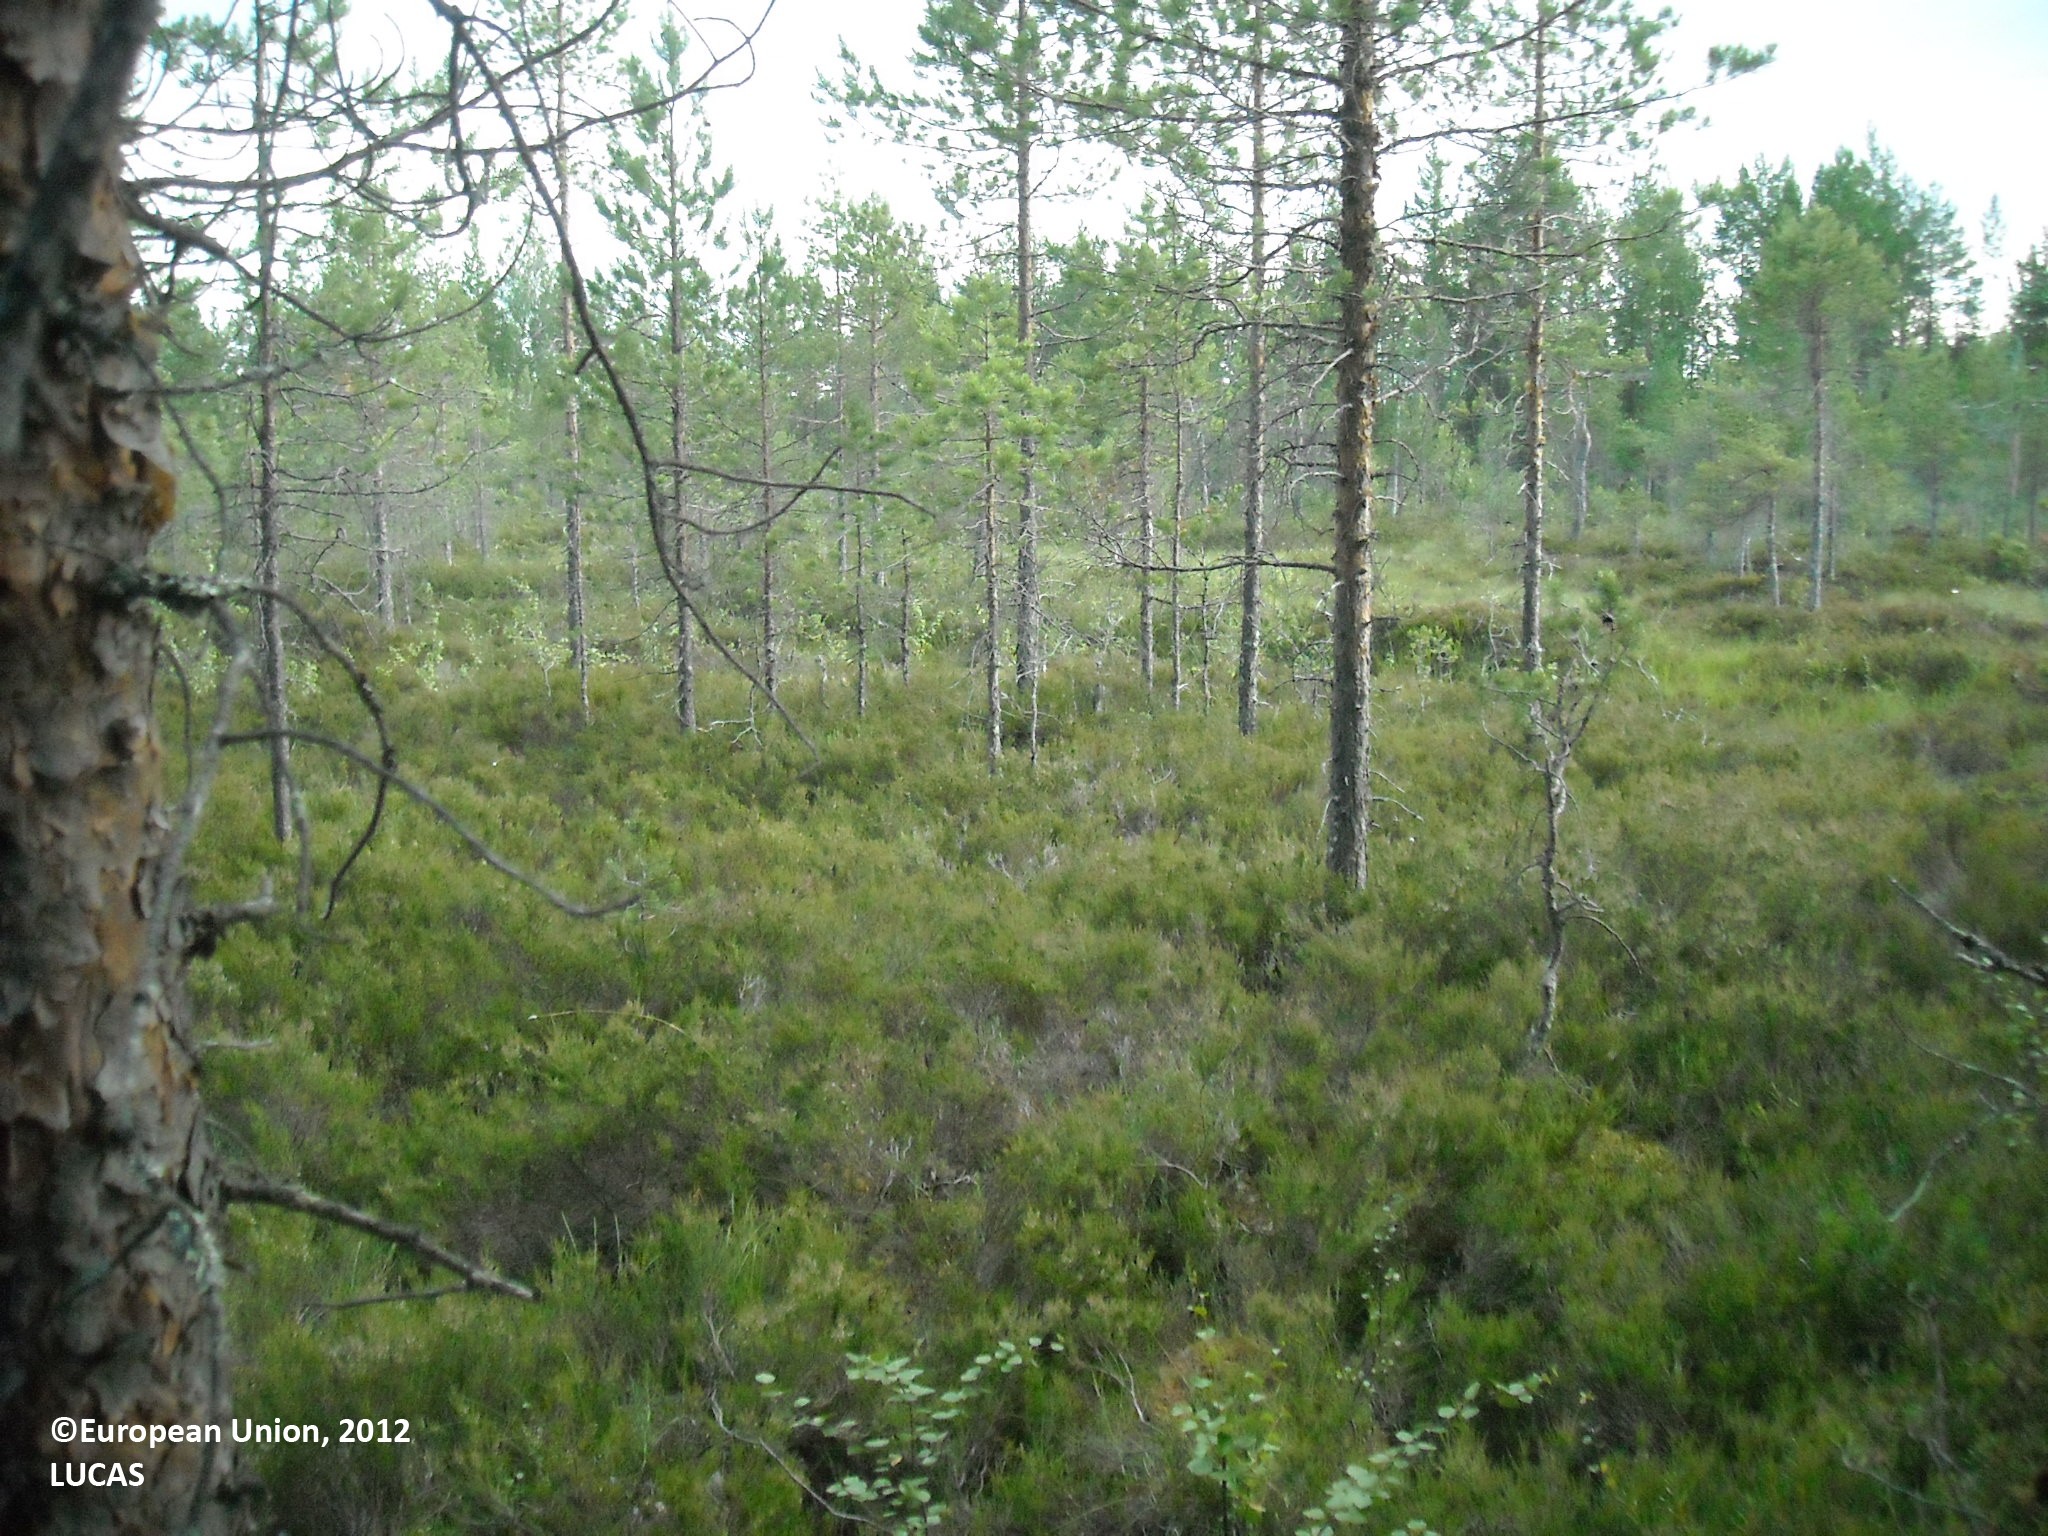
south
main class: Woodland
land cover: Pine dominated coniferous woodland
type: mire and swamp forests
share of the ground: 50 - 75 %
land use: Forestry
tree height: > 5 m
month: July
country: FI
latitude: 65.0703
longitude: 26.8065
